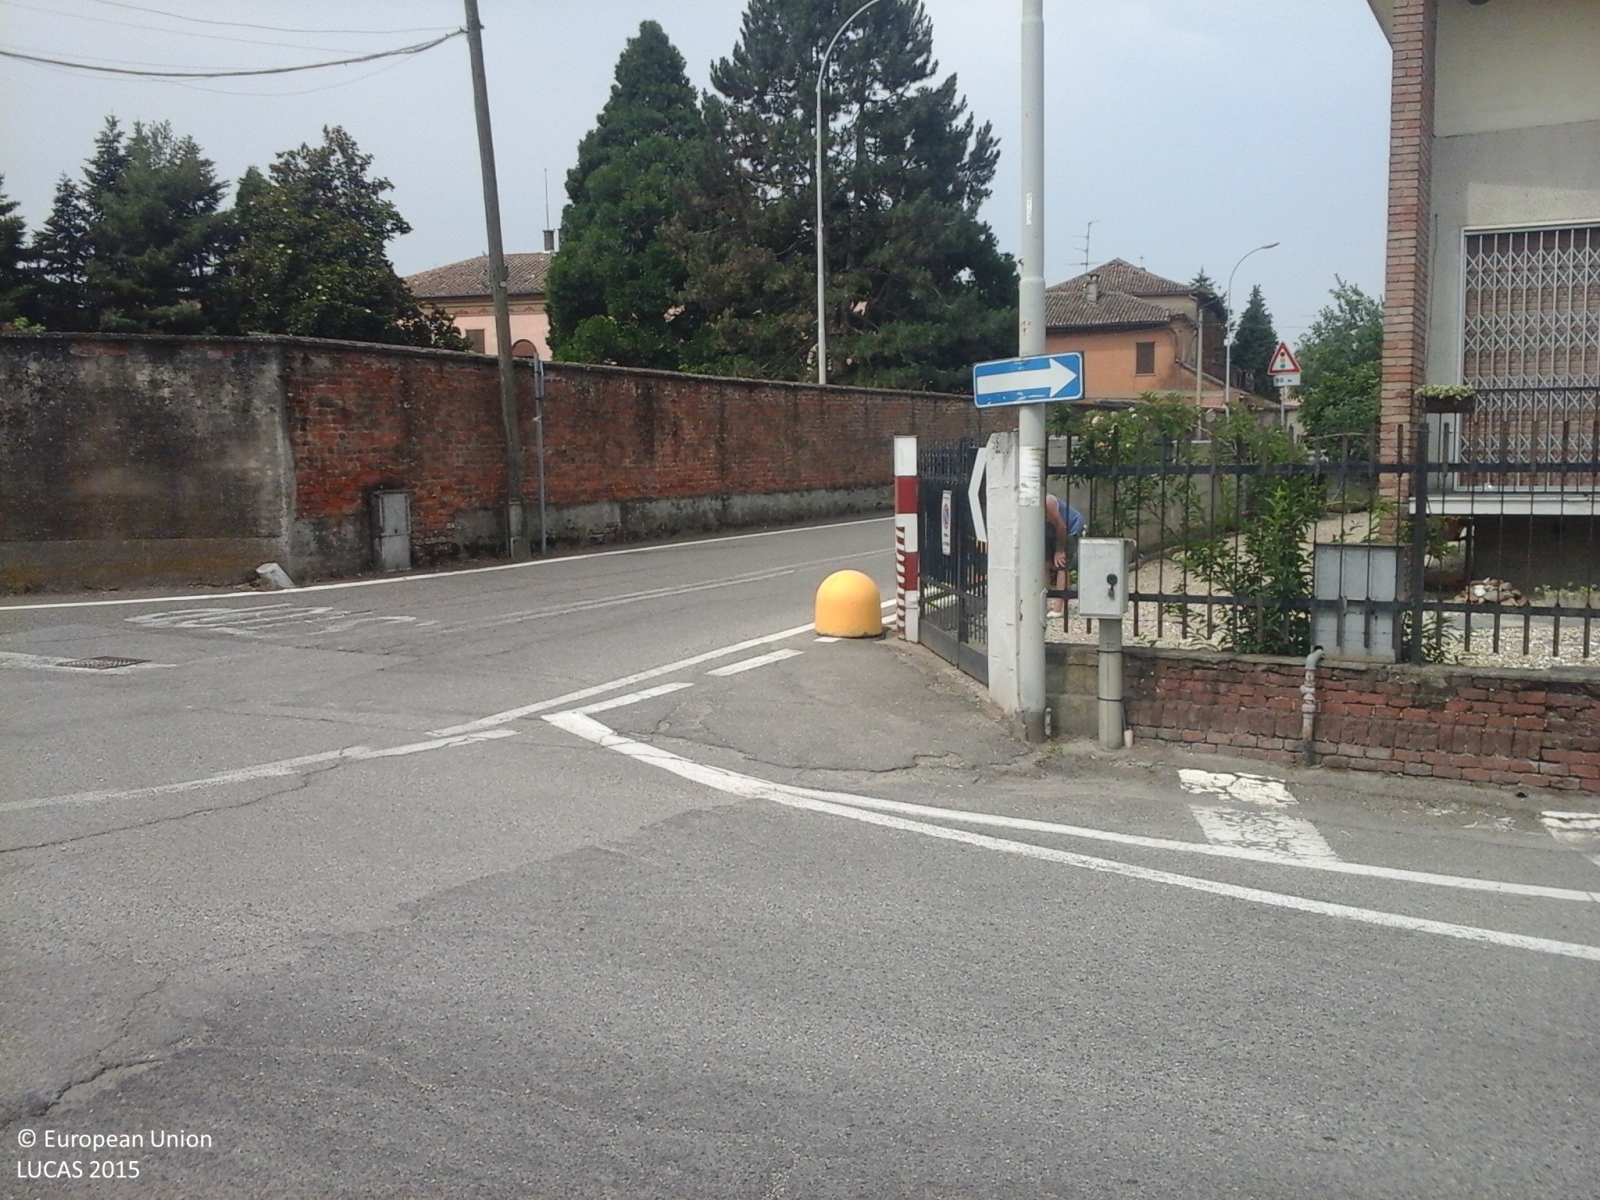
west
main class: Grassland
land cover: Grassland without tree/shrub cover
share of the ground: > 75 %
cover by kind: herbaceous plants 100 %
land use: Agriculture (excluding fallow land and kitchen gardens)
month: June
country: IT
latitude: 45.1190
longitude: 8.7946
